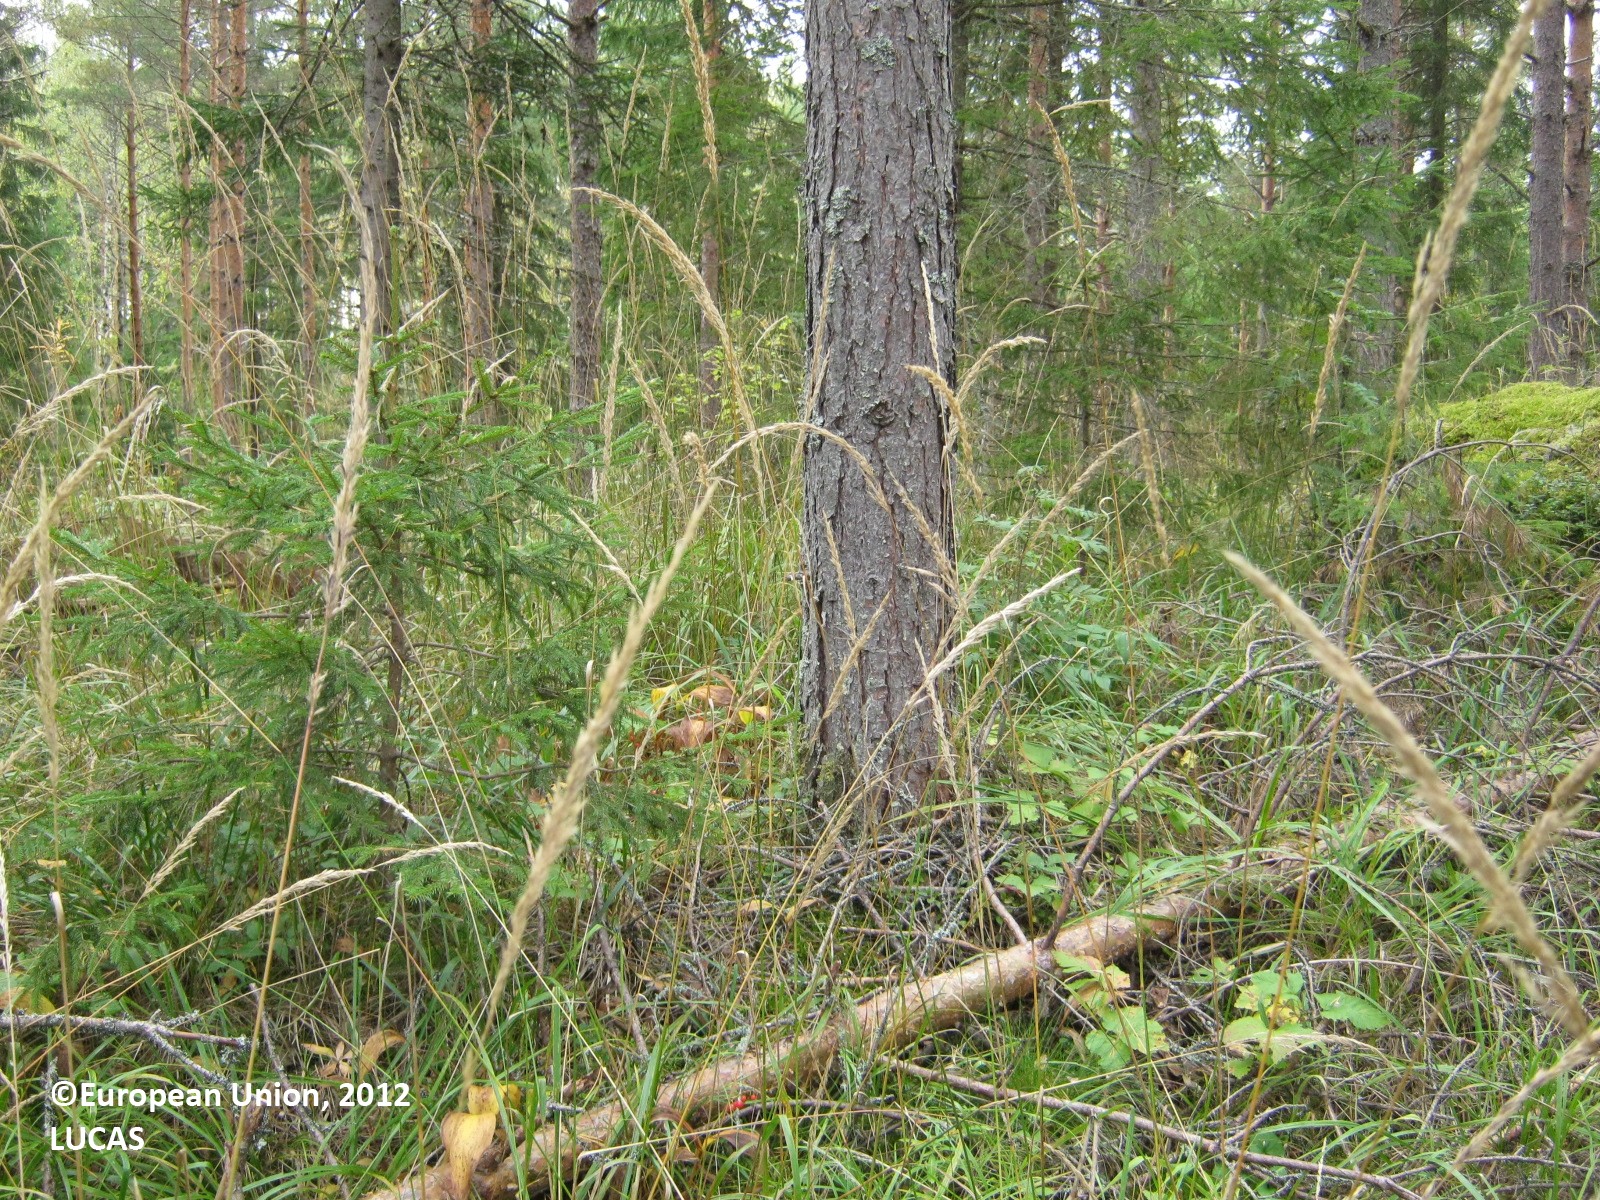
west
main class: Woodland
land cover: Pine dominated coniferous woodland
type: boreal forest
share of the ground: > 75 %
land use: Forestry
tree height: > 5 m
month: September
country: FI
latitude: 60.7371
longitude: 27.6677
